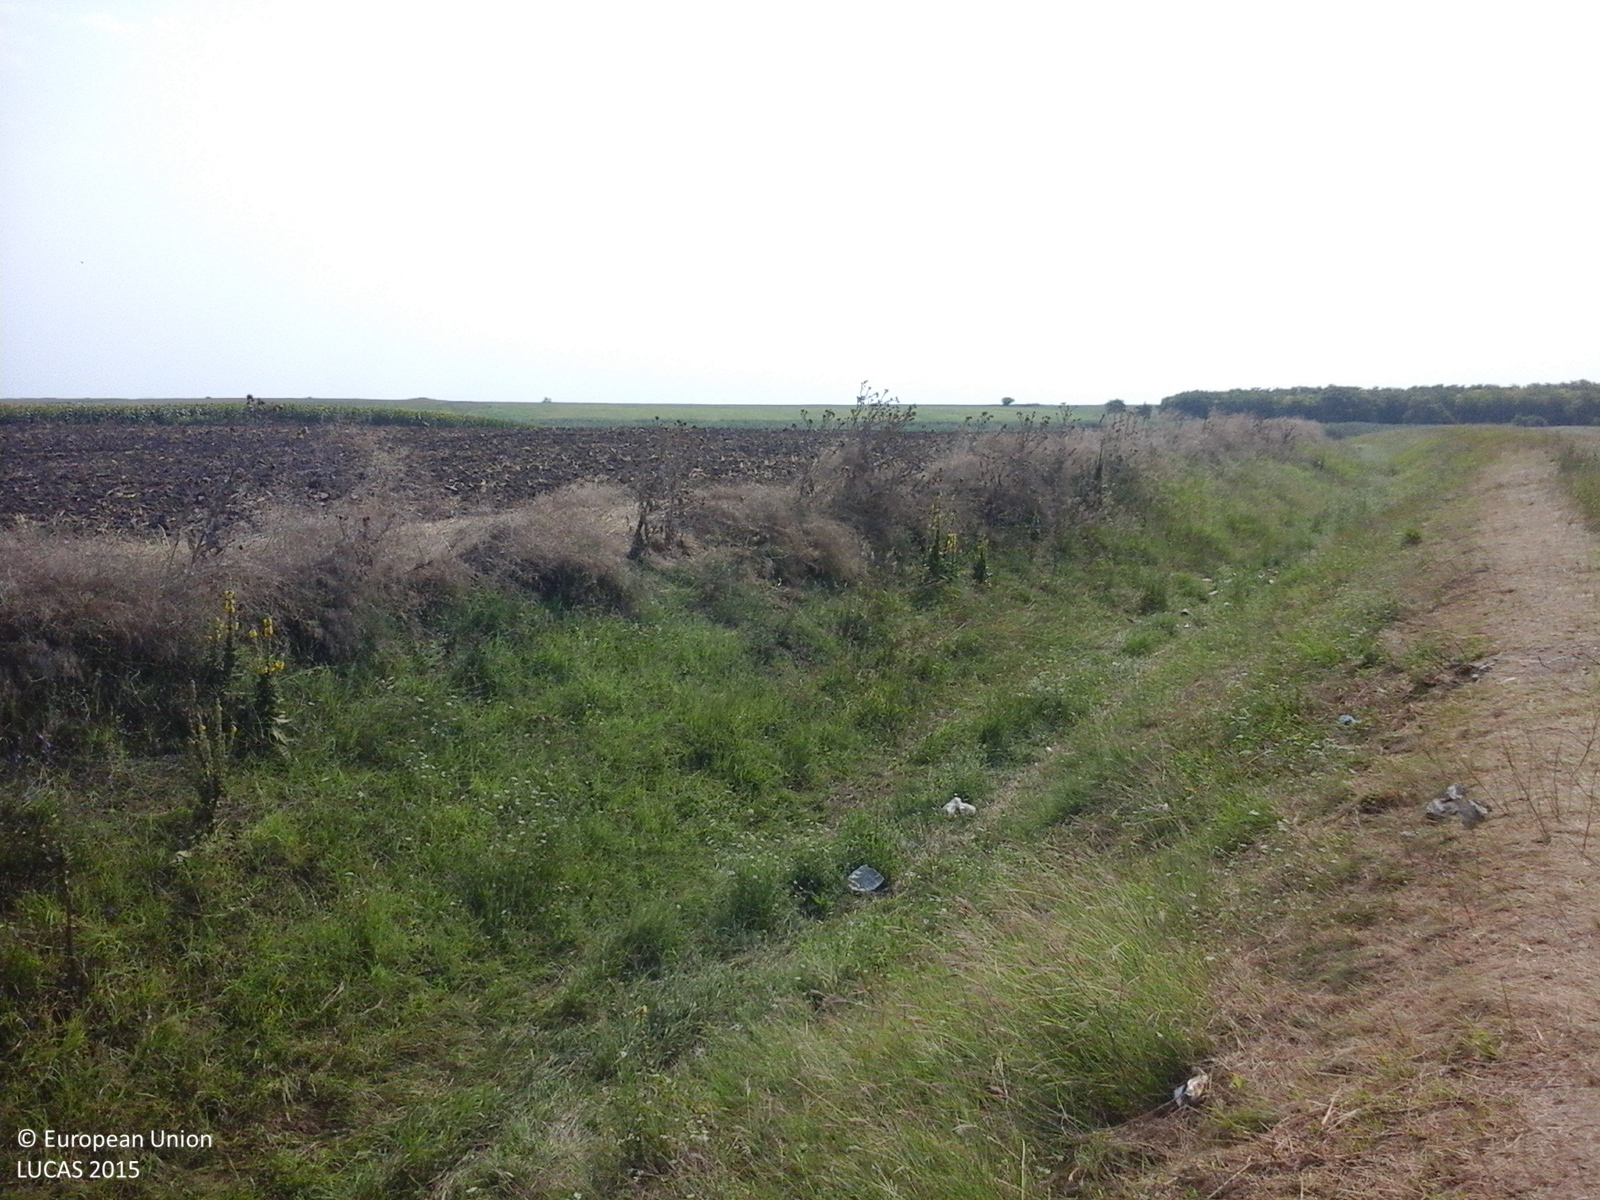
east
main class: Grassland
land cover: Spontaneously vegetated surfaces
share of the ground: > 75 %
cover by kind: herbaceous plants 100 %
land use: Fallow land
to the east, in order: Spontaneously vegetated surfaces; Ditches and canals; Spontaneously vegetated surfaces; Other bare soil; Grass margins; Tracks; Grassland without tree/shrub cover; Inland marshes
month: July
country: RO
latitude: 44.8099
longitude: 26.6746
